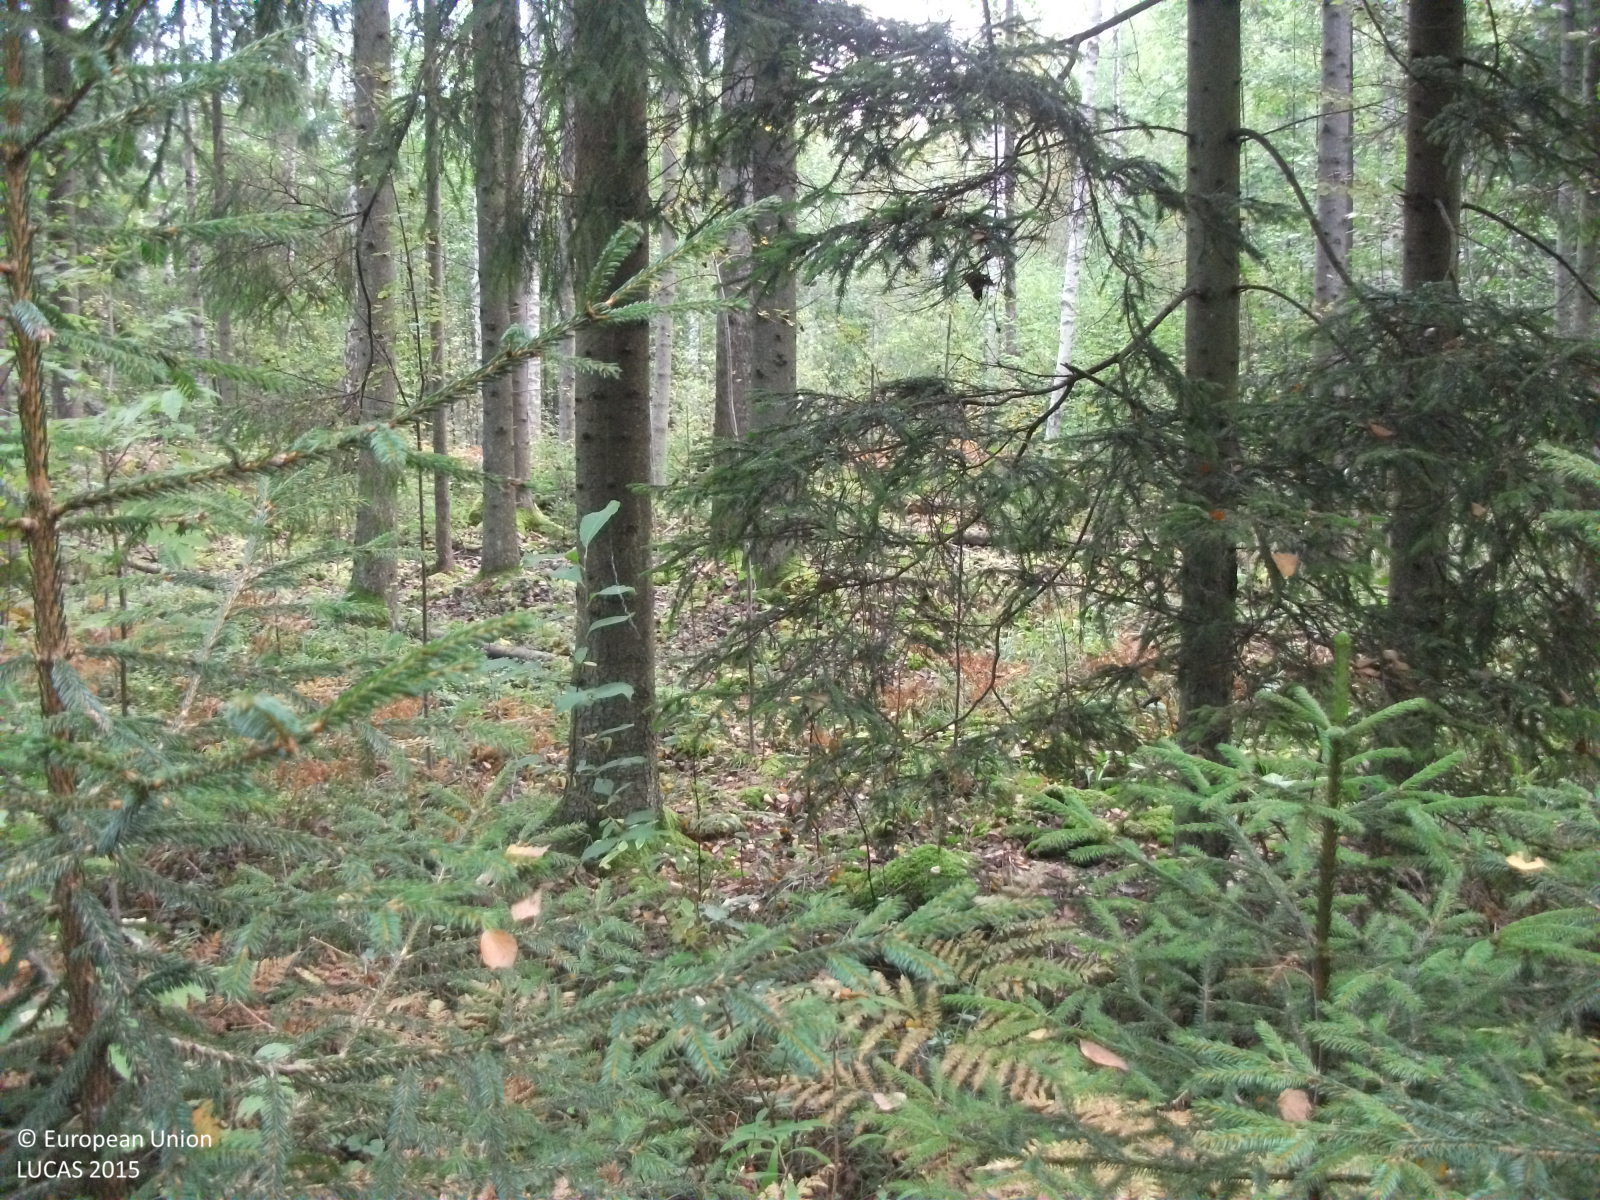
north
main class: Woodland
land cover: Spruce dominated mixed woodland
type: hemiboreal forest and nemoral coniferous forest and mixed broadleaved-coniferous forest
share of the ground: > 75 %
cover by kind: broadleaved forest trees 50 %, coniferous forest trees 35 %, herbaceous plants 10 %, shrubs 5 %
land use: Forestry
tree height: > 5 m
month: September
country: LV
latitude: 57.6948
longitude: 24.3982
